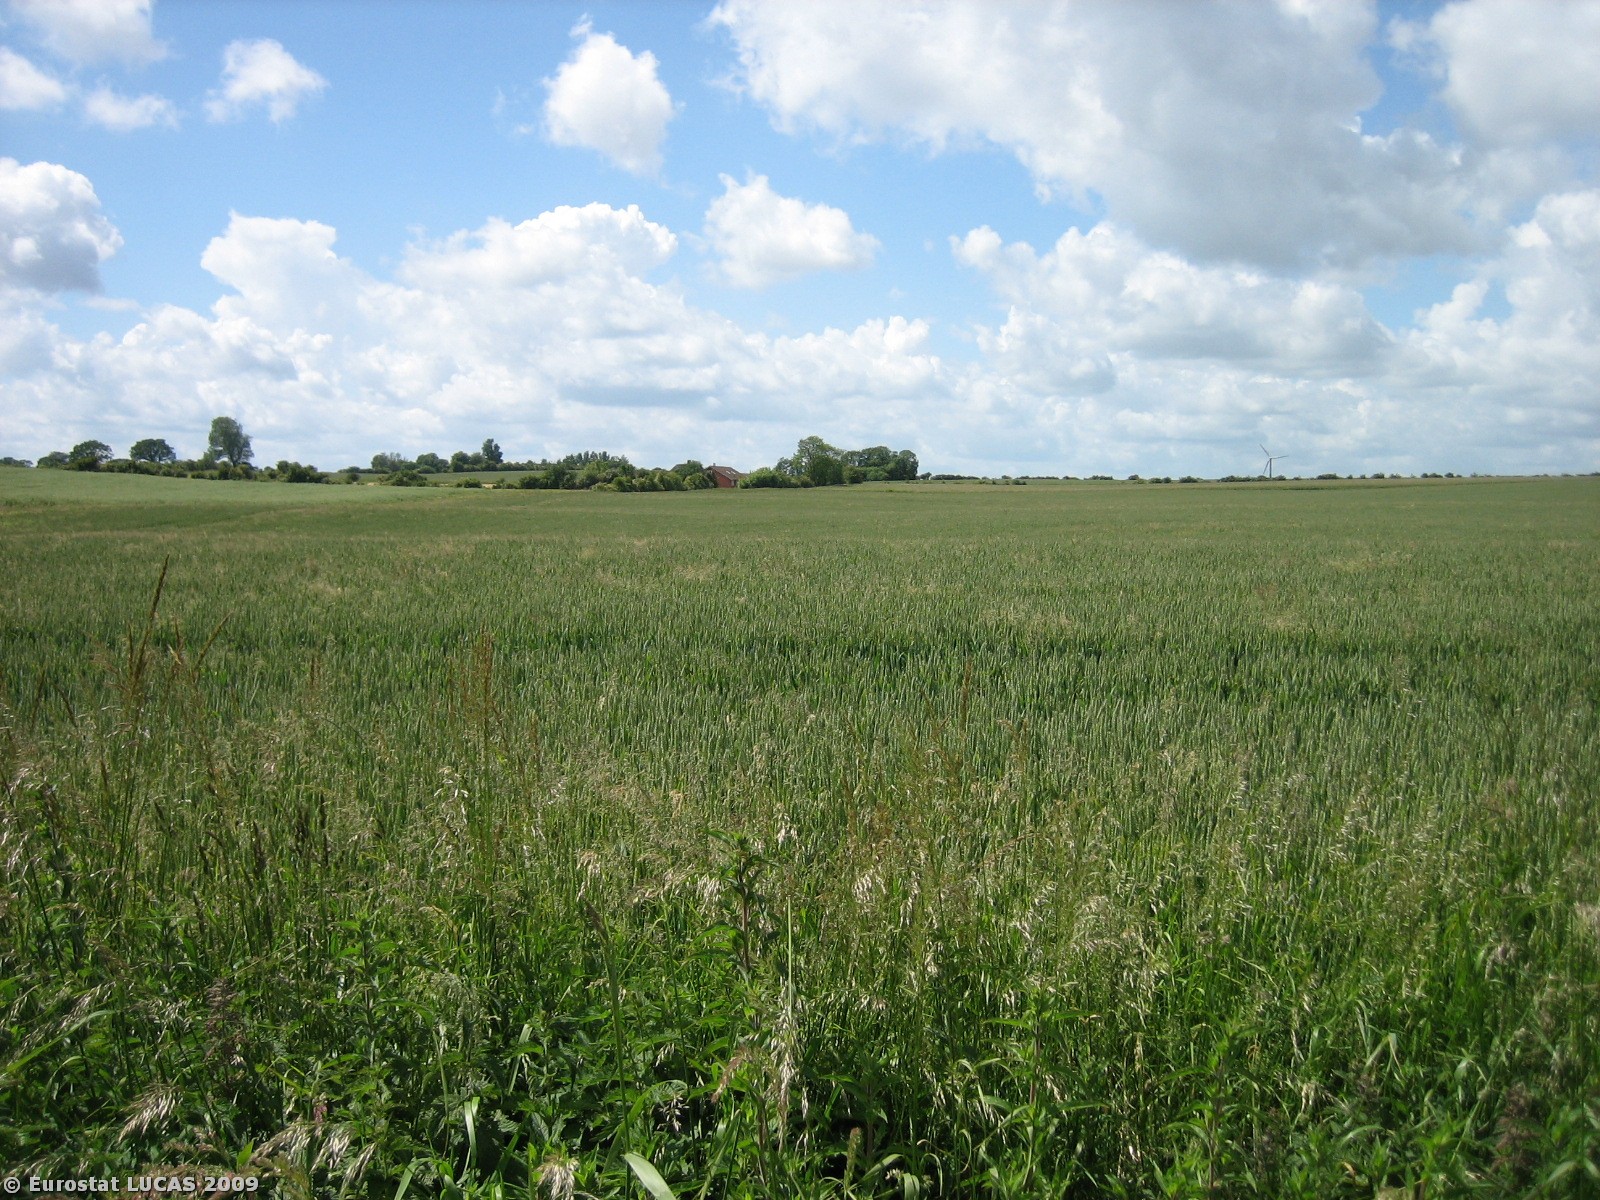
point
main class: Cropland
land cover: Common wheat
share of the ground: > 75 %
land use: Agriculture (excluding fallow land and kitchen gardens)
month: June
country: DK
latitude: 55.6124
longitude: 9.7938
